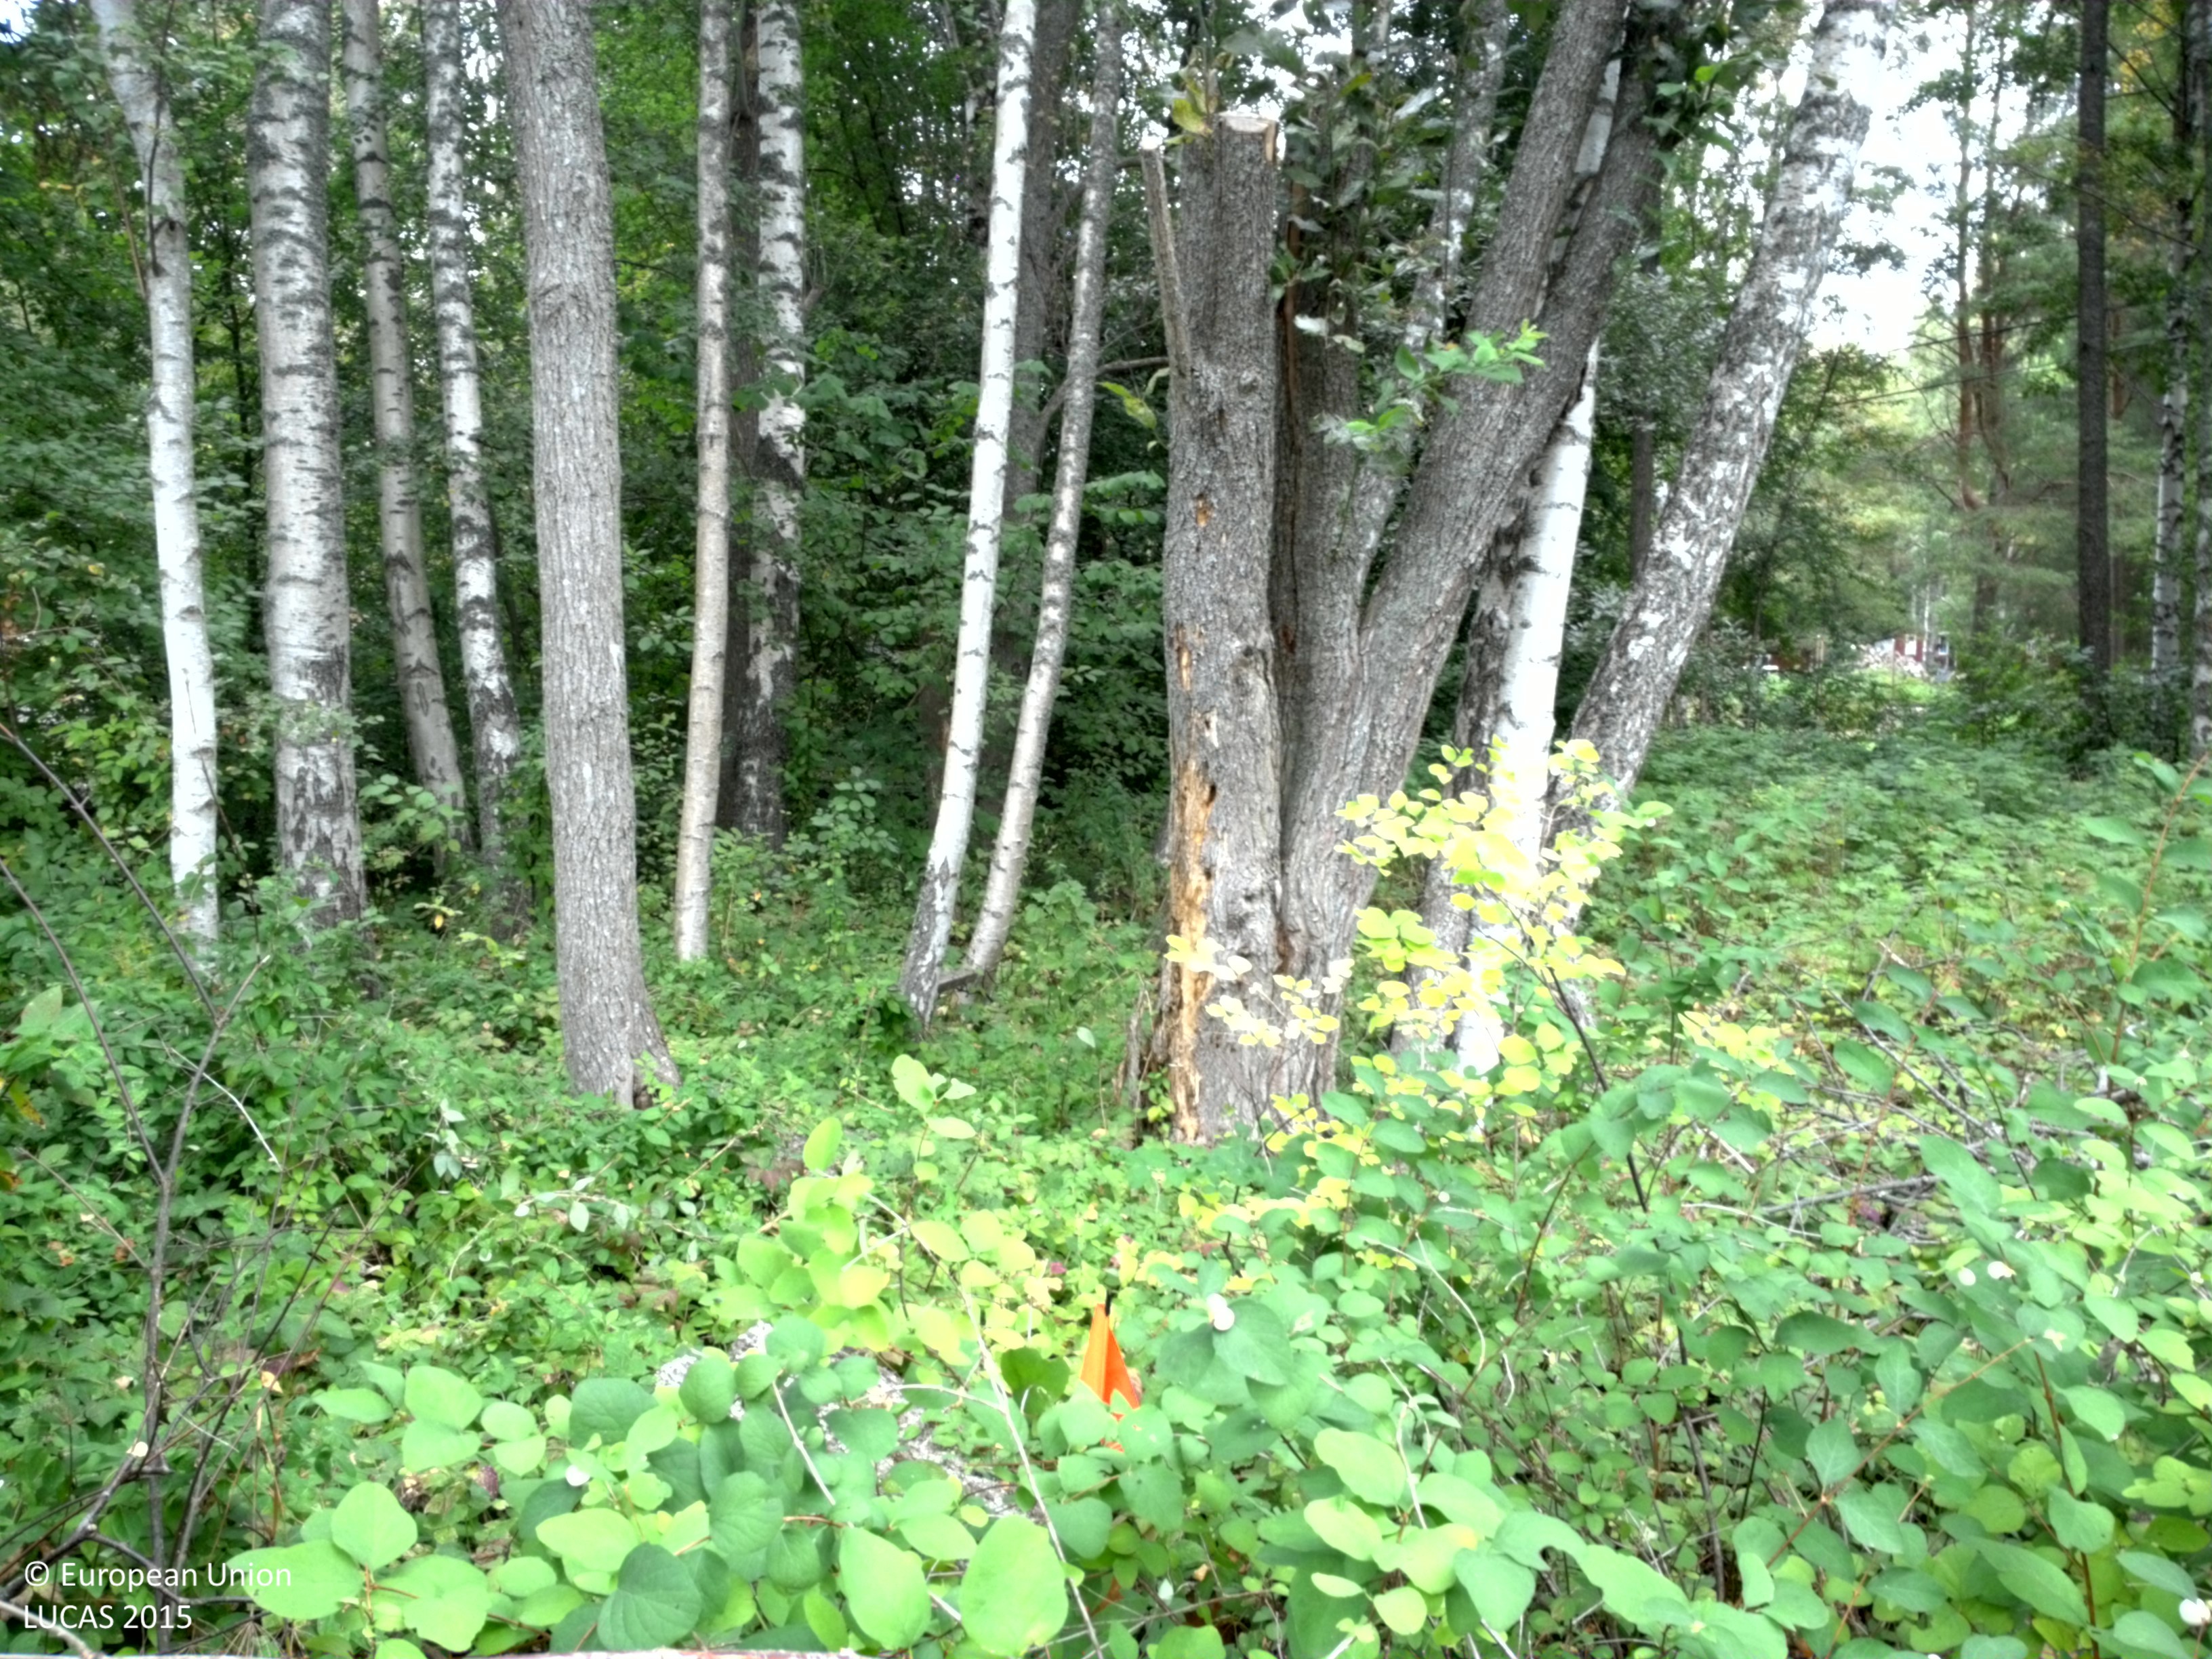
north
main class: Woodland
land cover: Broadleaved woodland
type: boreal forest
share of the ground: 50 - 75 %
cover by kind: broadleaved forest trees 65 %, shrubs 20 %, coniferous forest trees 10 %, herbaceous plants 5 %
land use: Amenities, museums, leisure
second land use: Residential
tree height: > 5 m
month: September
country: SE
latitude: 59.2376
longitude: 18.4674
